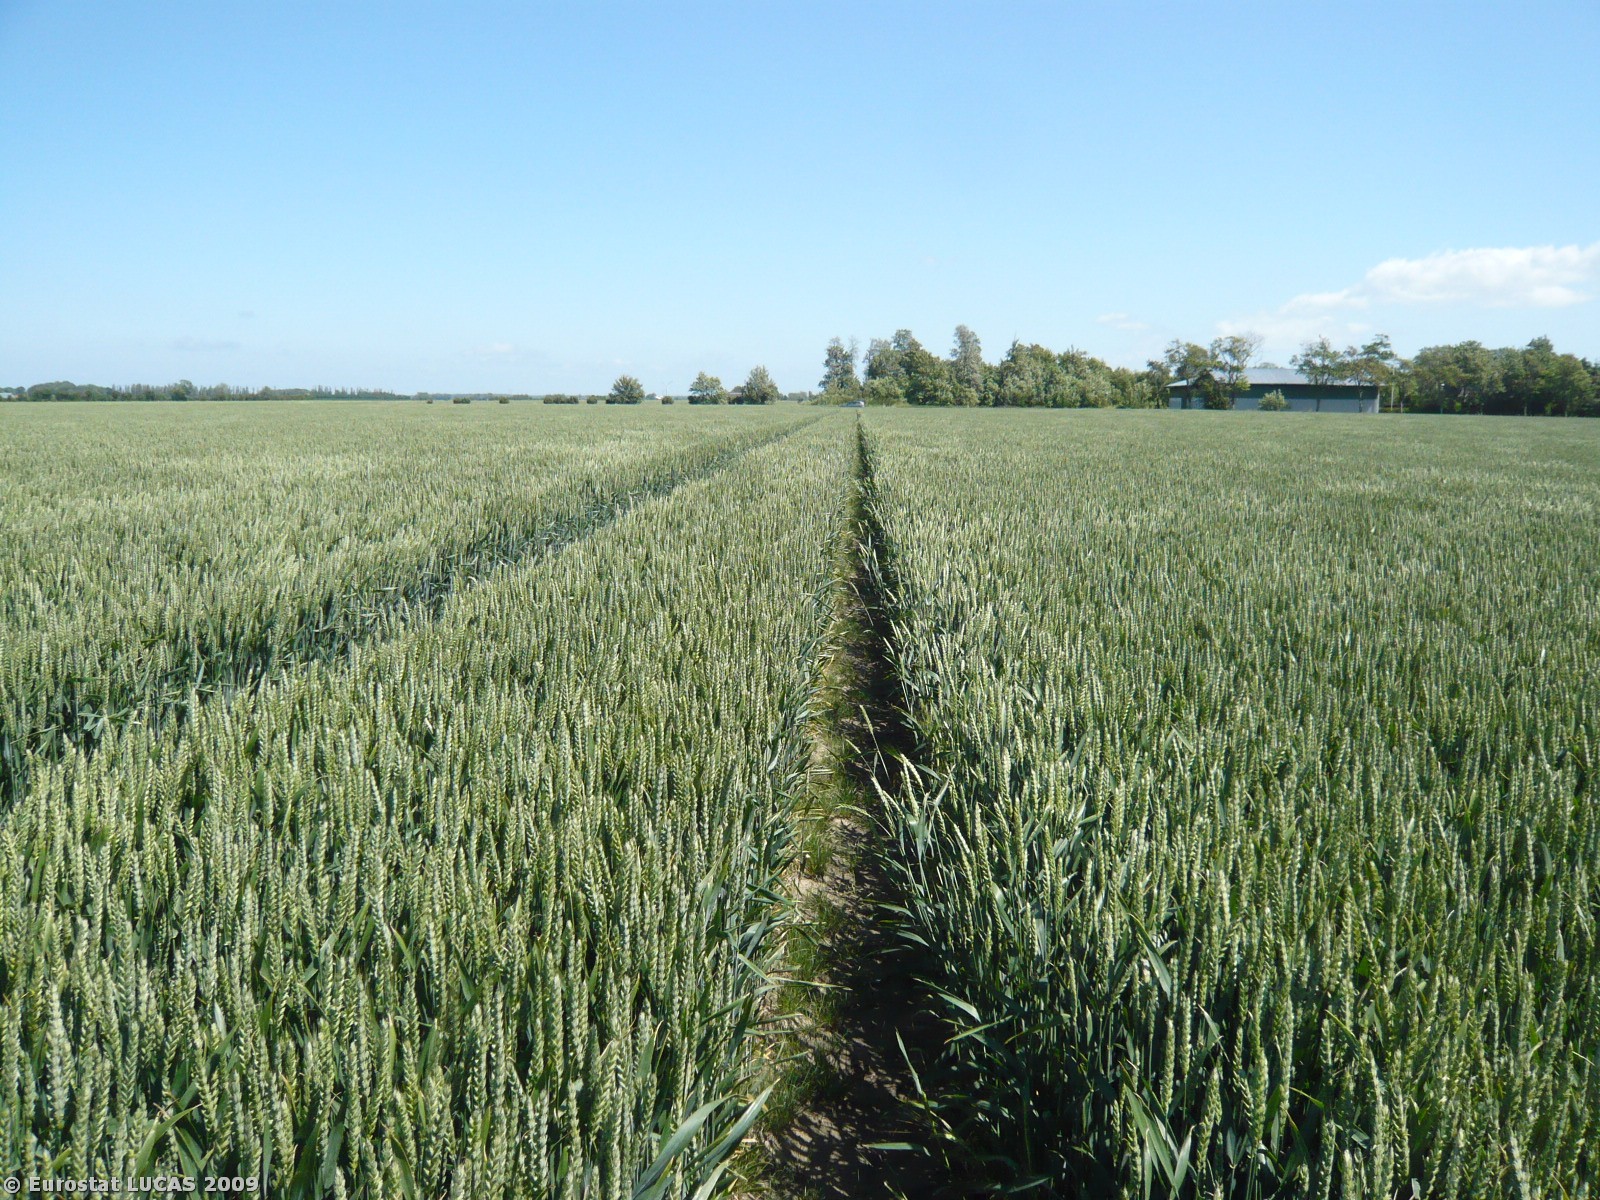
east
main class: Cropland
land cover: Common wheat
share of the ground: > 75 %
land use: Agriculture (excluding fallow land and kitchen gardens)
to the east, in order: Common wheat; Tracks; Grass margins; Common wheat
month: June
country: DK
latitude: 54.7621
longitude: 11.1958
